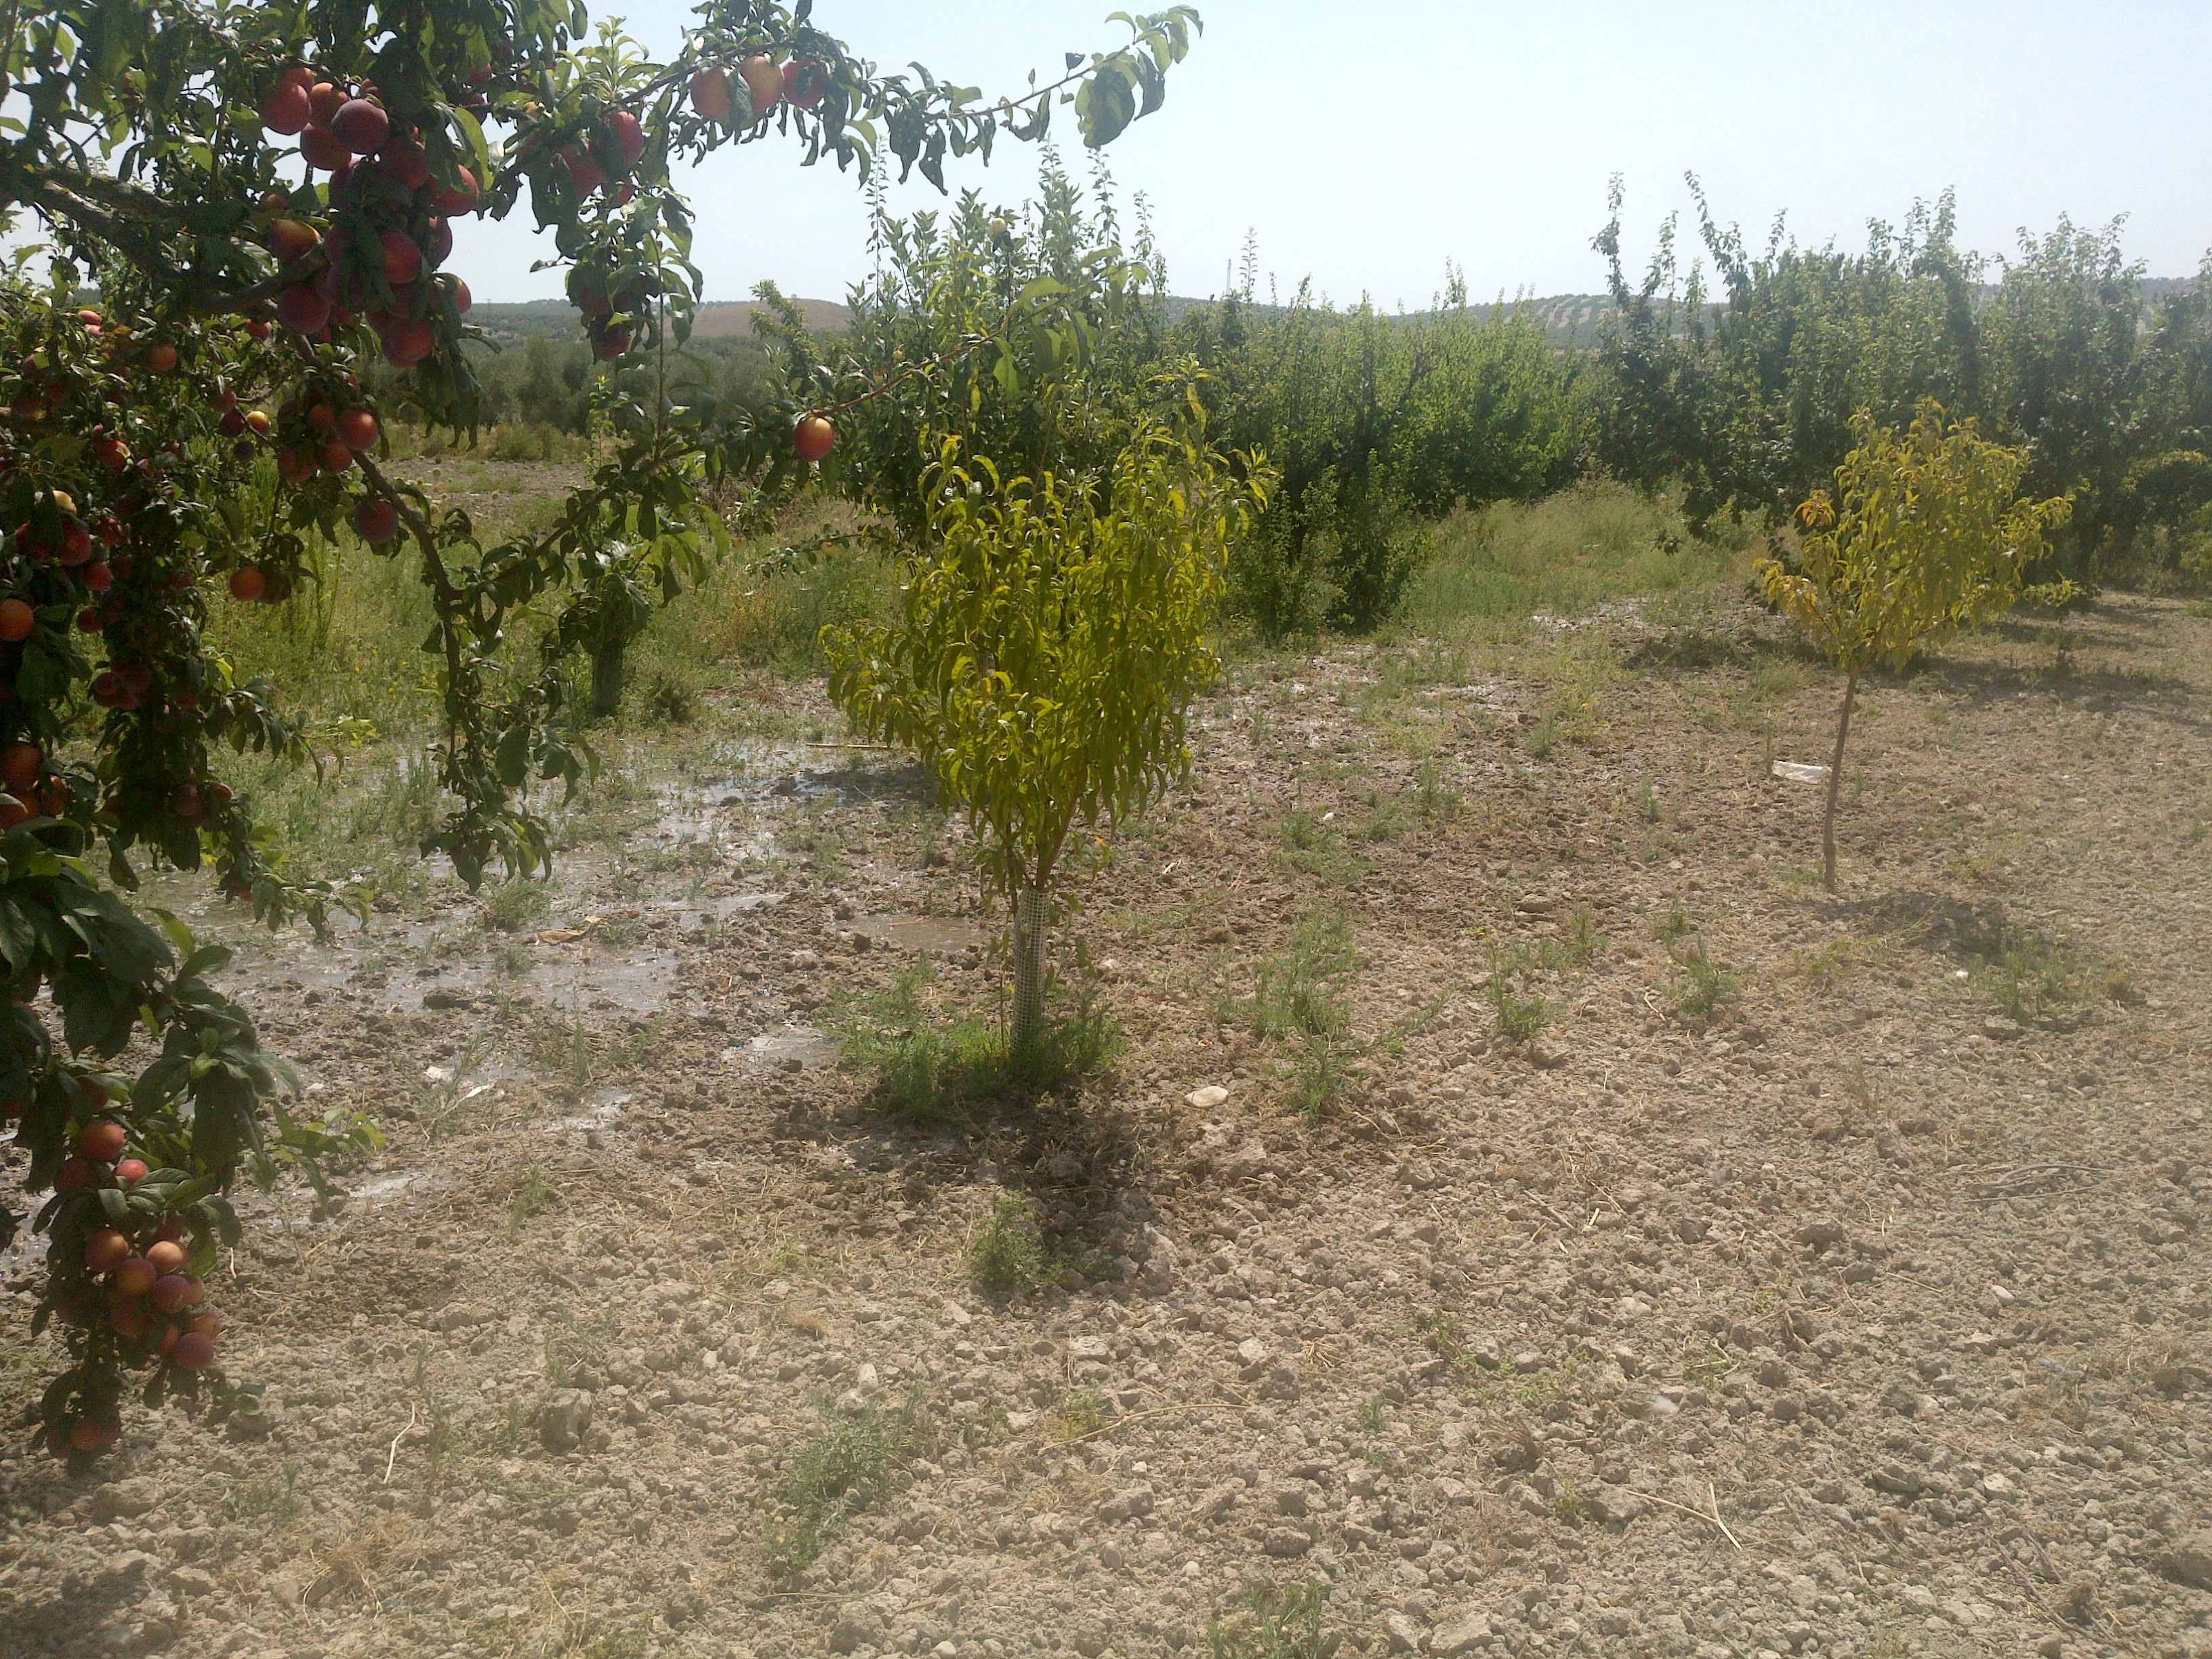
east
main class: Cropland
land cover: Other fruit trees and berries
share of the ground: 25 - 50 %
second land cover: Spontaneously vegetated surfaces
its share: 10 - 25 %
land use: Agriculture (excluding fallow land and kitchen gardens)
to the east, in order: Other fruit trees and berries; Spontaneously vegetated surfaces; Single bushes/trees; Spontaneously vegetated surfaces; Tracks; Olive groves; Electric lines; Olive groves
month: June
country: ES
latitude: 37.6637
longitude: -4.2309
